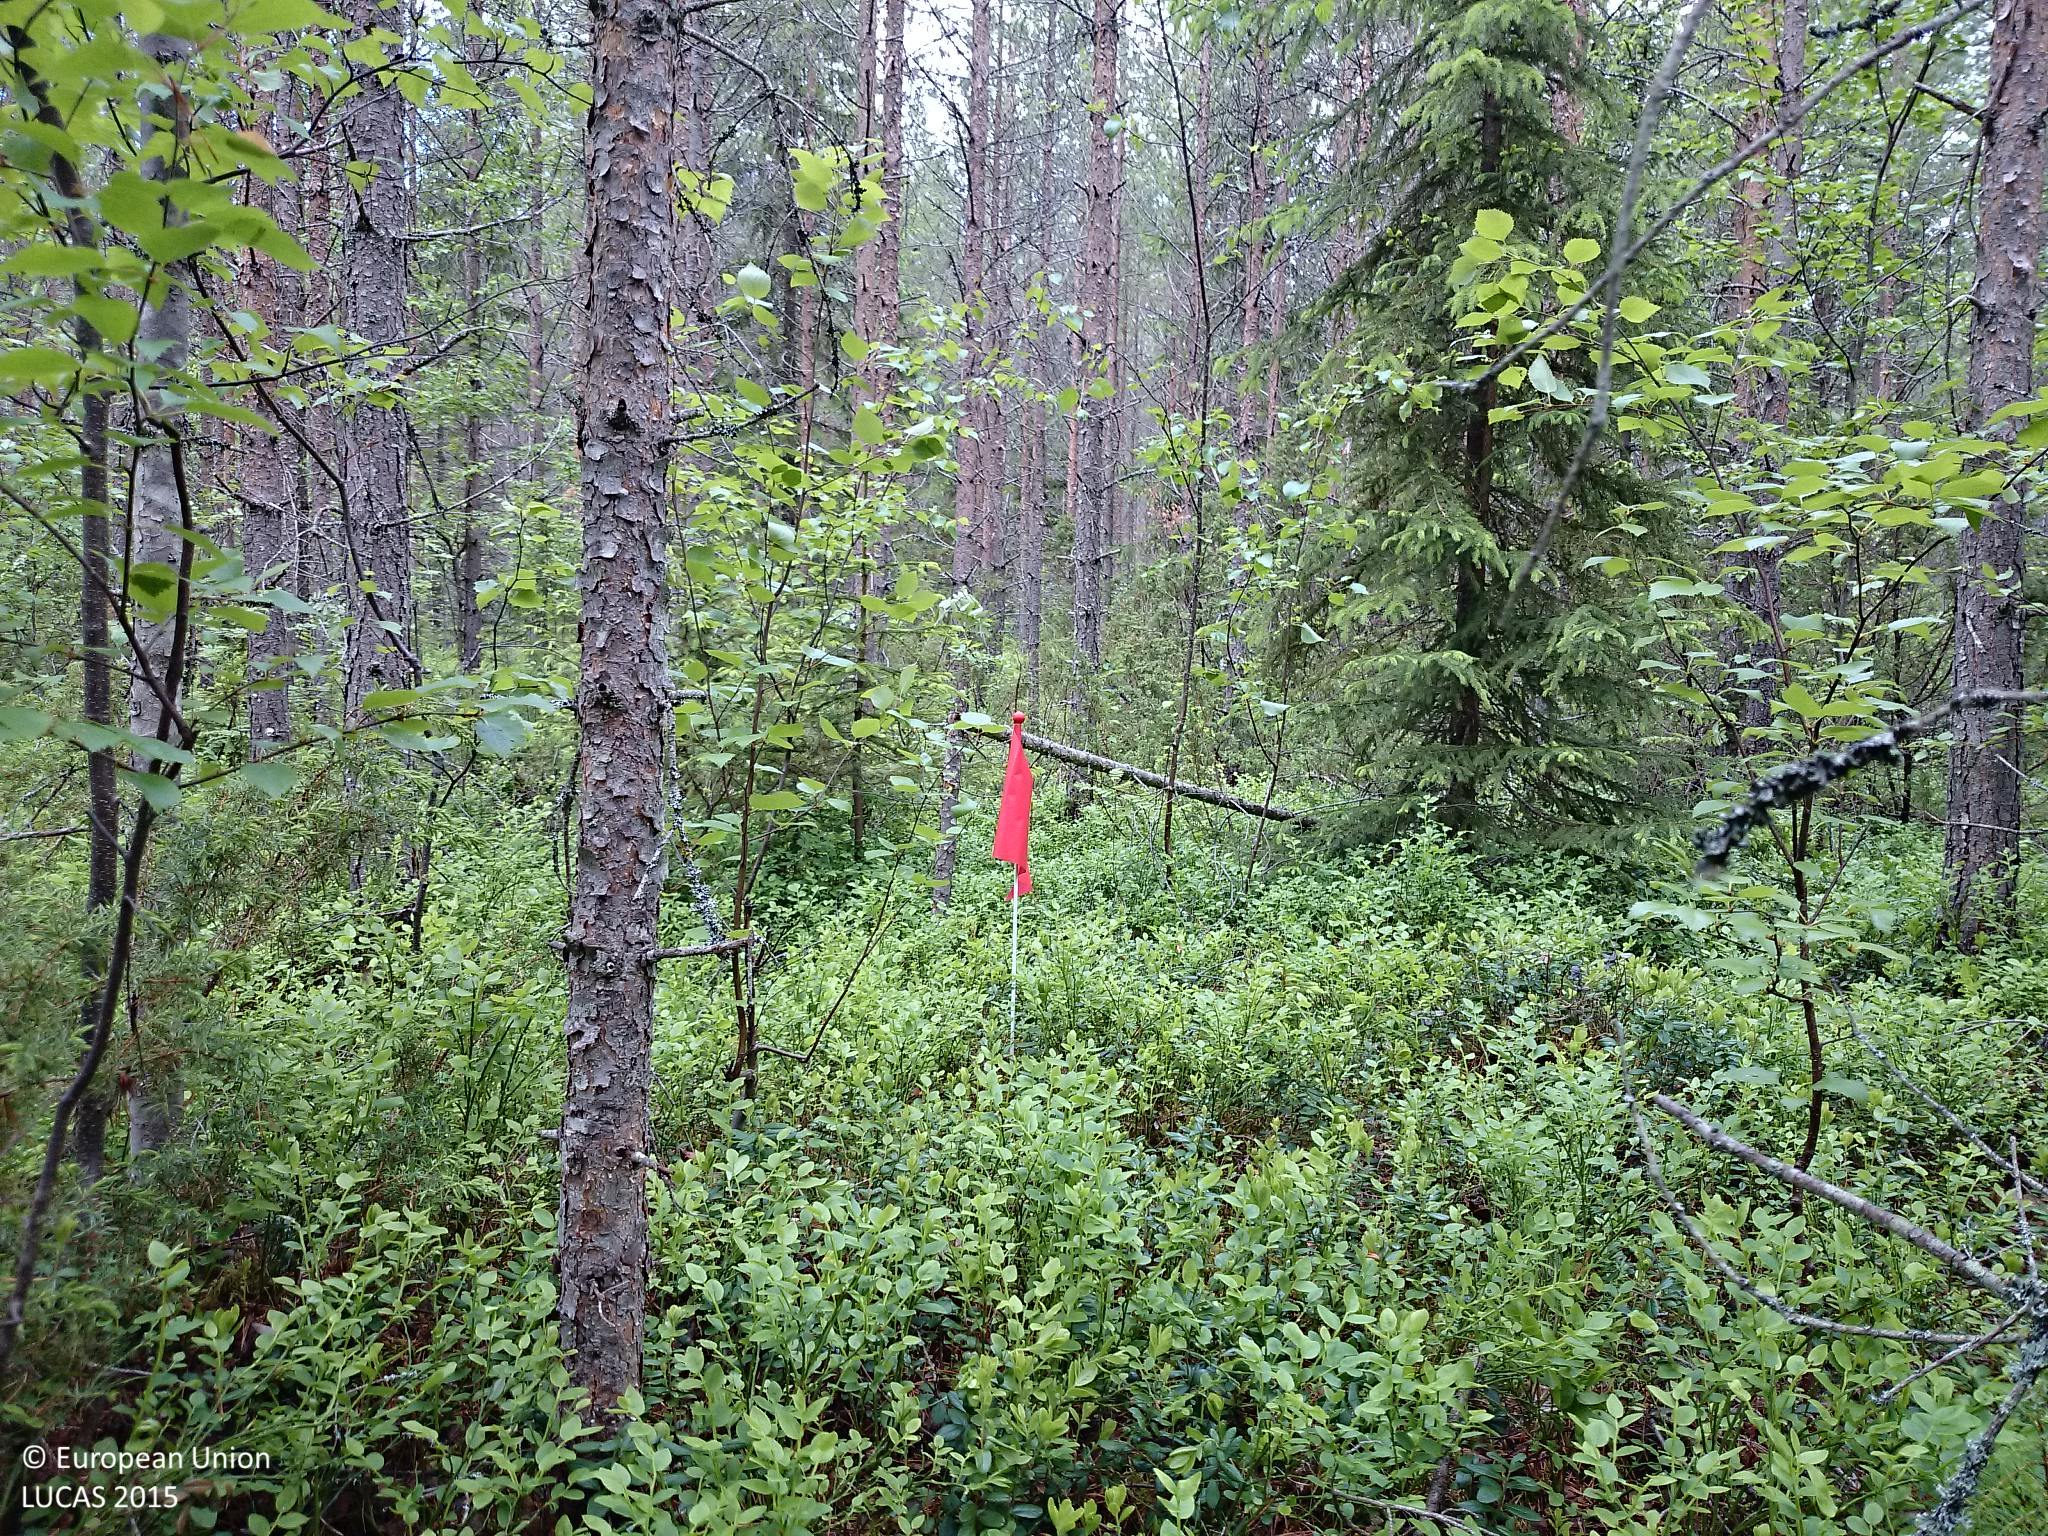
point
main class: Woodland
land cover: Pine dominated mixed woodland
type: boreal forest
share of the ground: > 75 %
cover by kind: coniferous forest trees 60 %, broadleaved forest trees 20 %, shrubs 20 %
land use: Forestry
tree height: > 5 m
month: June
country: SE
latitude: 64.1404
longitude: 20.7708
